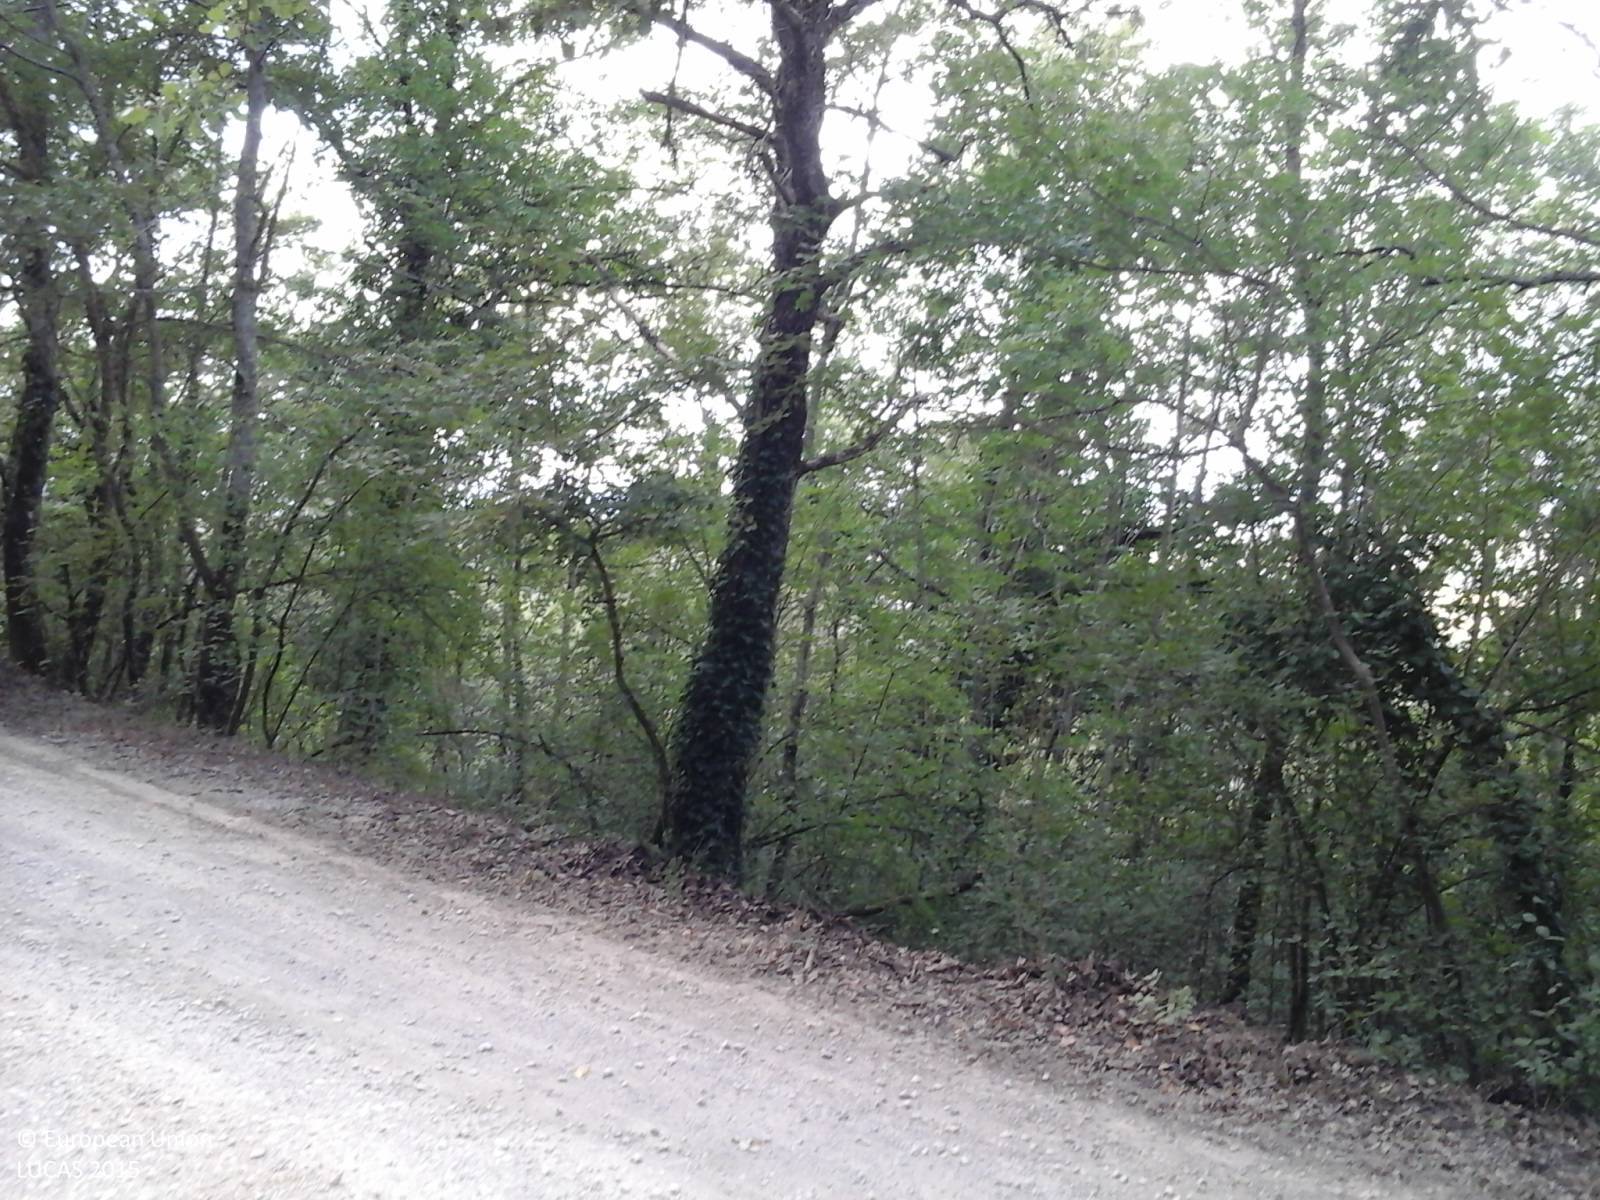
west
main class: Woodland
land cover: Broadleaved woodland
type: mesophytic deciduous forest
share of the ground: > 75 %
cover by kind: broadleaved forest trees 95 %, shrubs 5 %
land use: Forestry
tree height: > 5 m
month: September
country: IT
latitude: 43.0123
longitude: 12.0673
